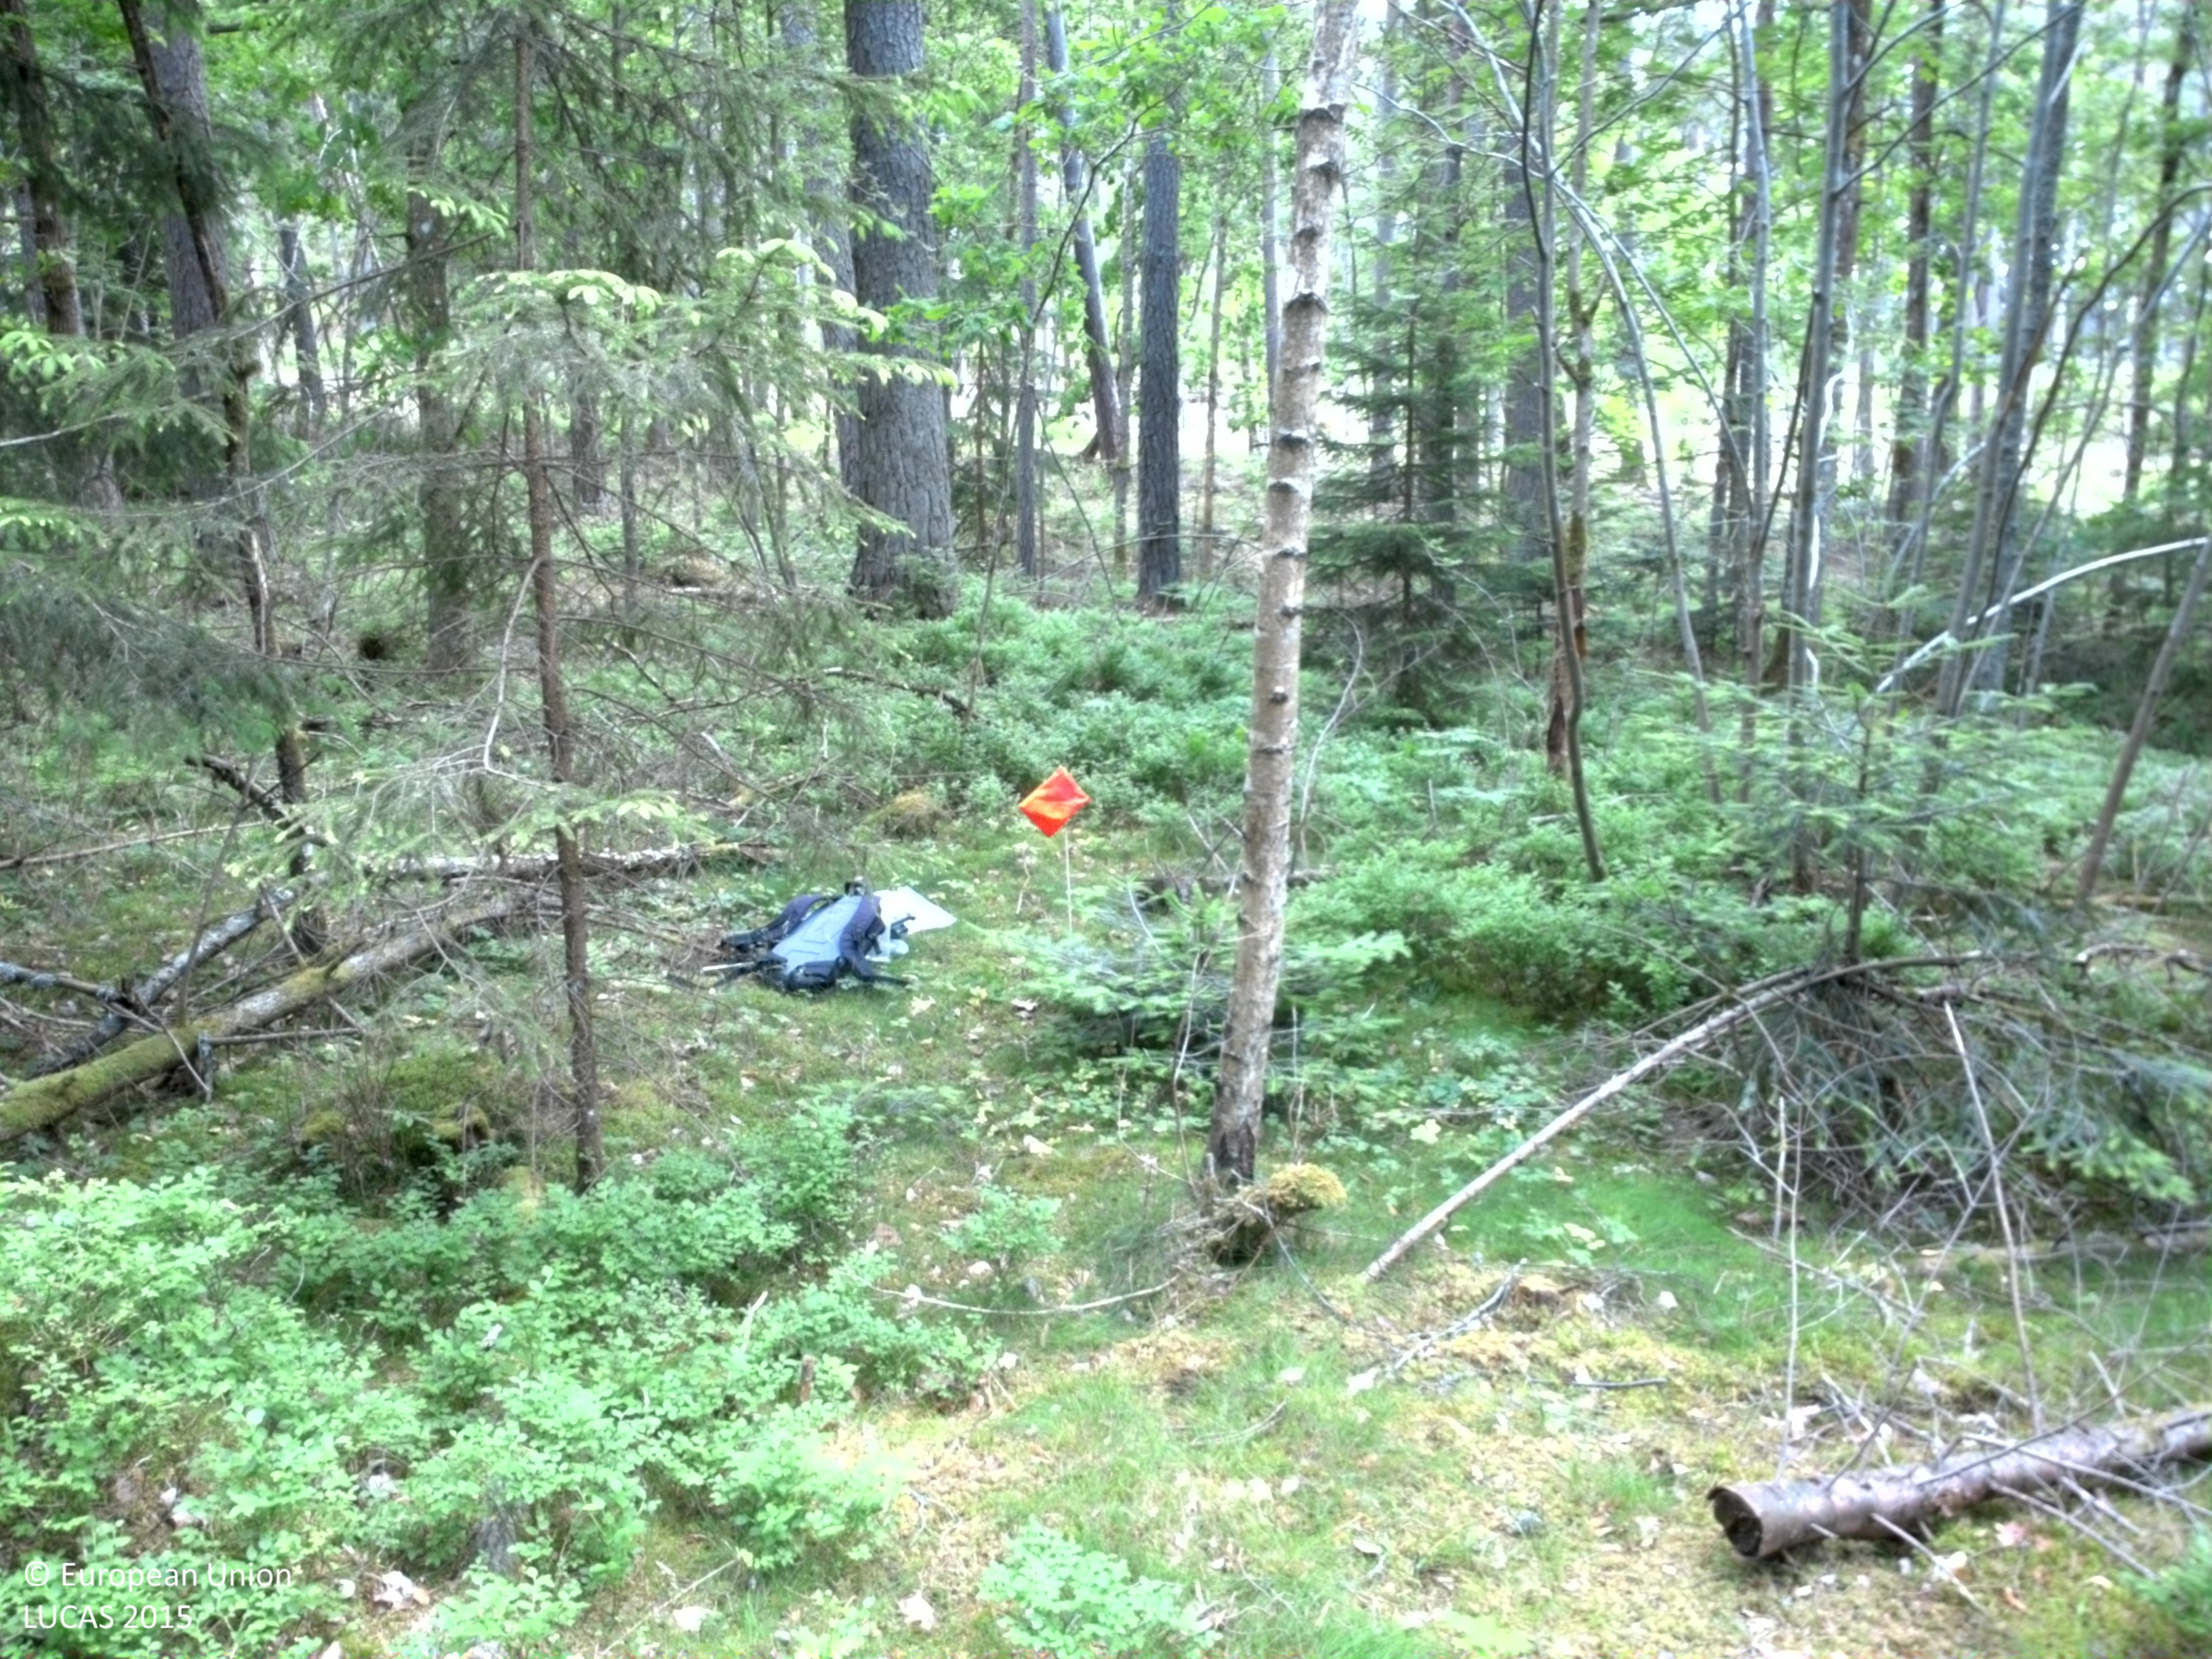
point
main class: Woodland
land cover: Pine dominated mixed woodland
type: boreal forest
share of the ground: 25 - 50 %
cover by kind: herbaceous plants 45 %, coniferous forest trees 25 %, broadleaved forest trees 20 %, lichens and mosses 10 %
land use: Amenities, museums, leisure
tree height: > 5 m
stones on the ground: < 10 %
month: June
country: SE
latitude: 58.4858
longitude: 16.3249
